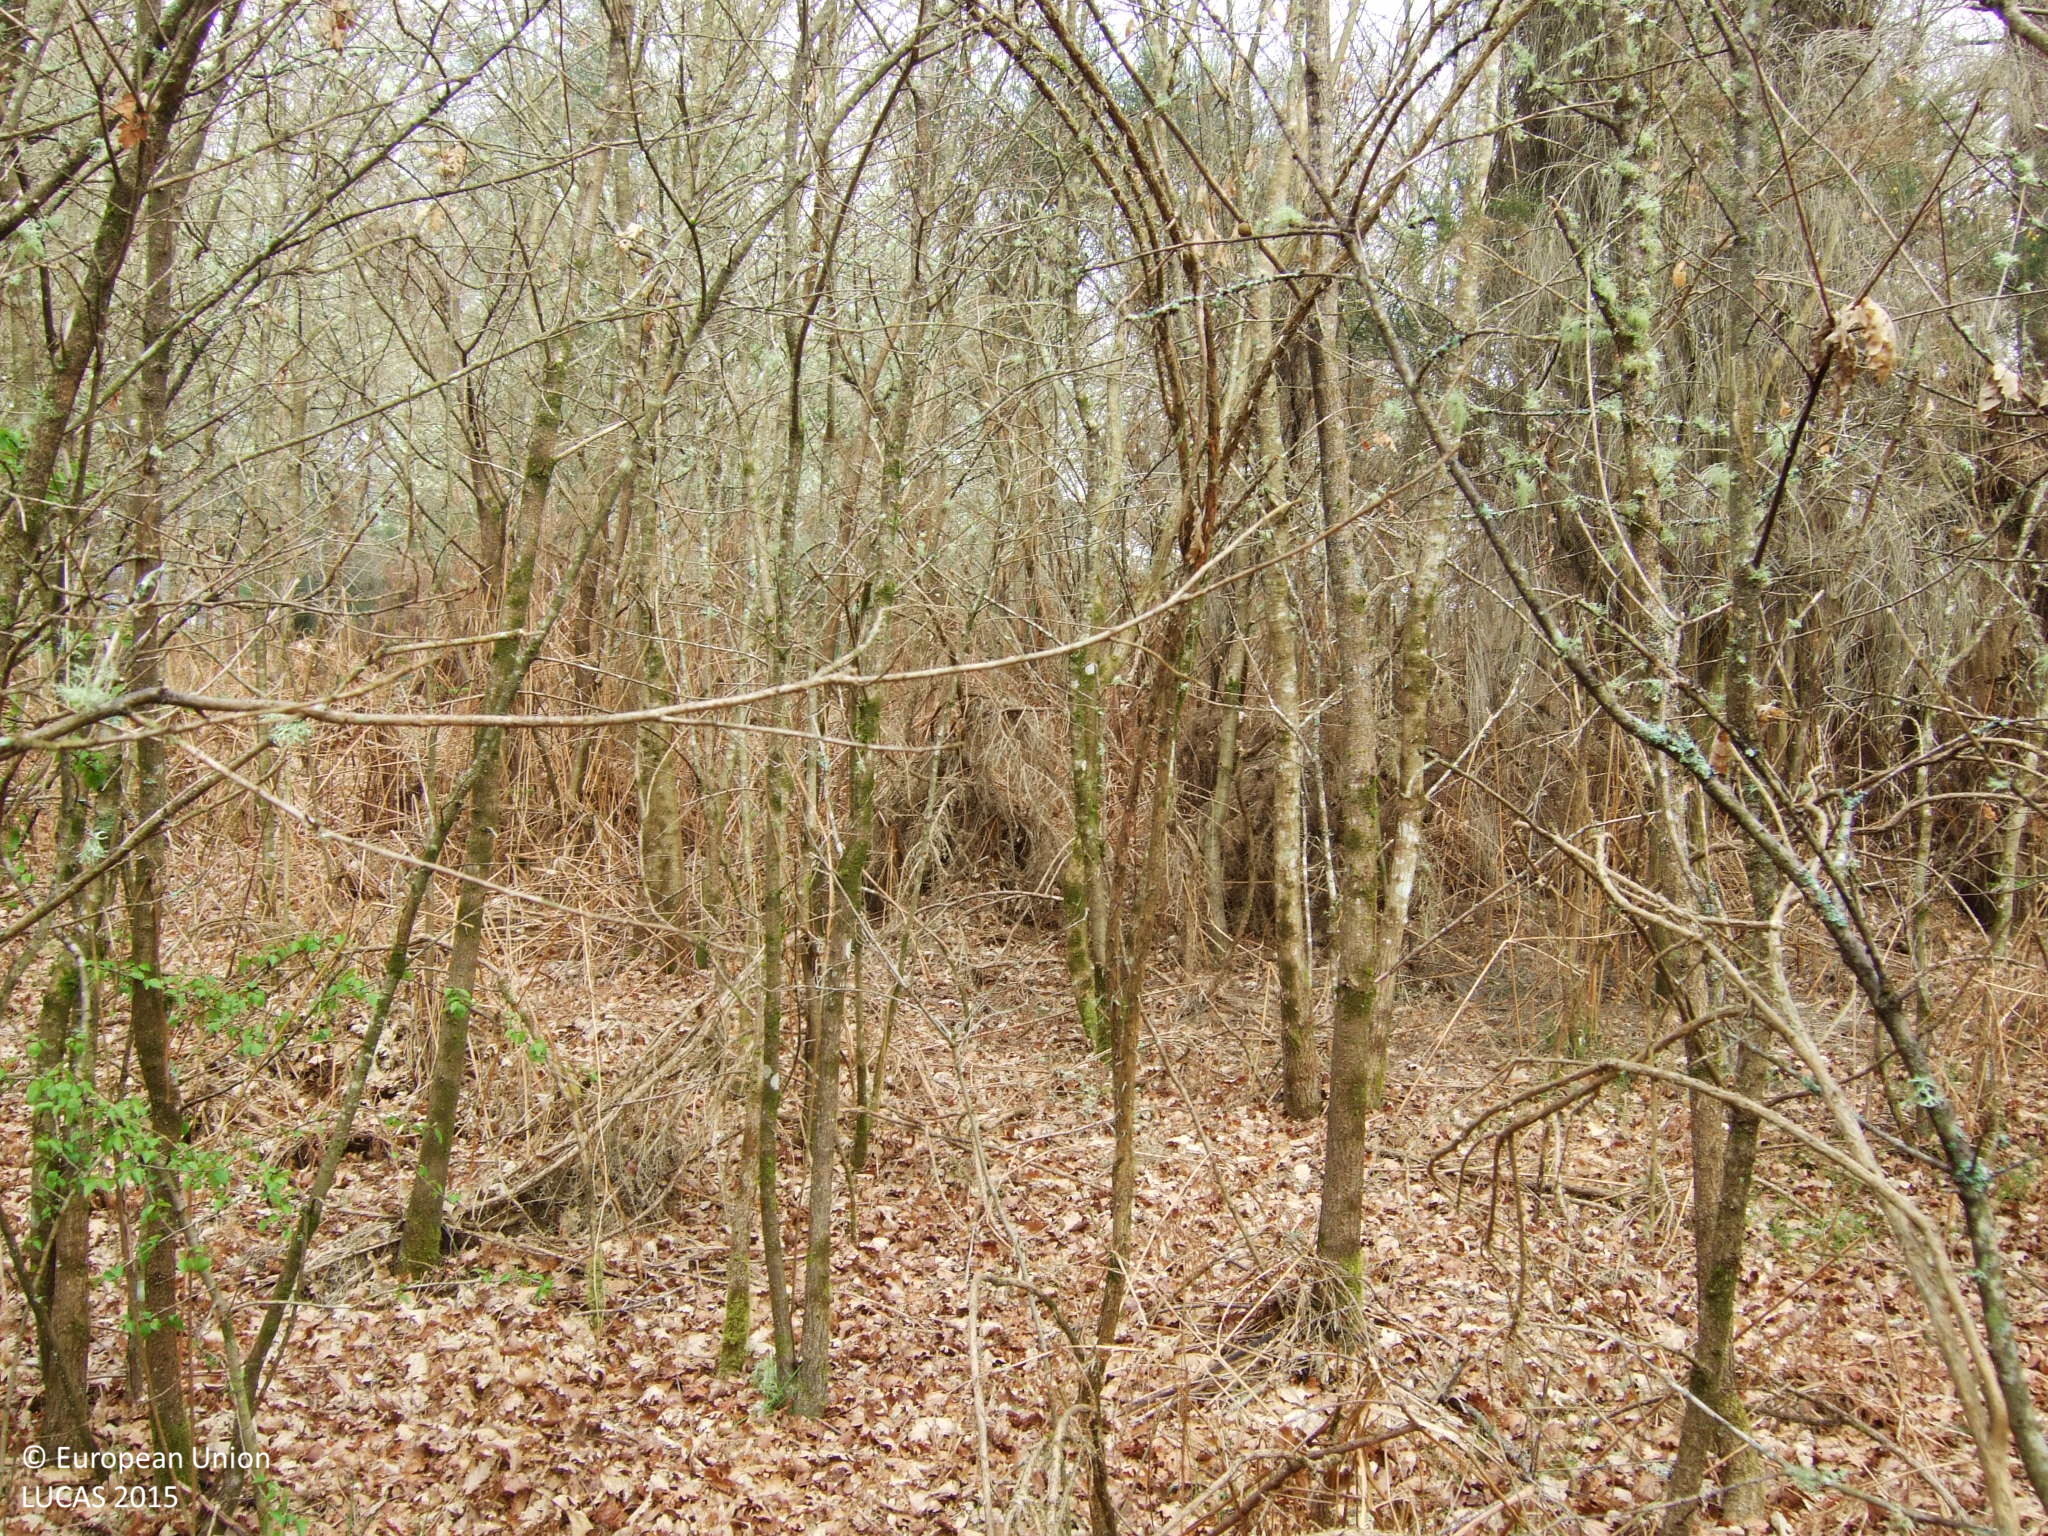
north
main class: Woodland
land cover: Broadleaved woodland
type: acidophilous oak and oak-birch forest
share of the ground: 50 - 75 %
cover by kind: broadleaved forest trees 70 %, shrubs 30 %
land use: Semi-natural and natural areas not in use
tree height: > 5 m
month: April
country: ES
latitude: 42.7750
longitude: -7.8160
